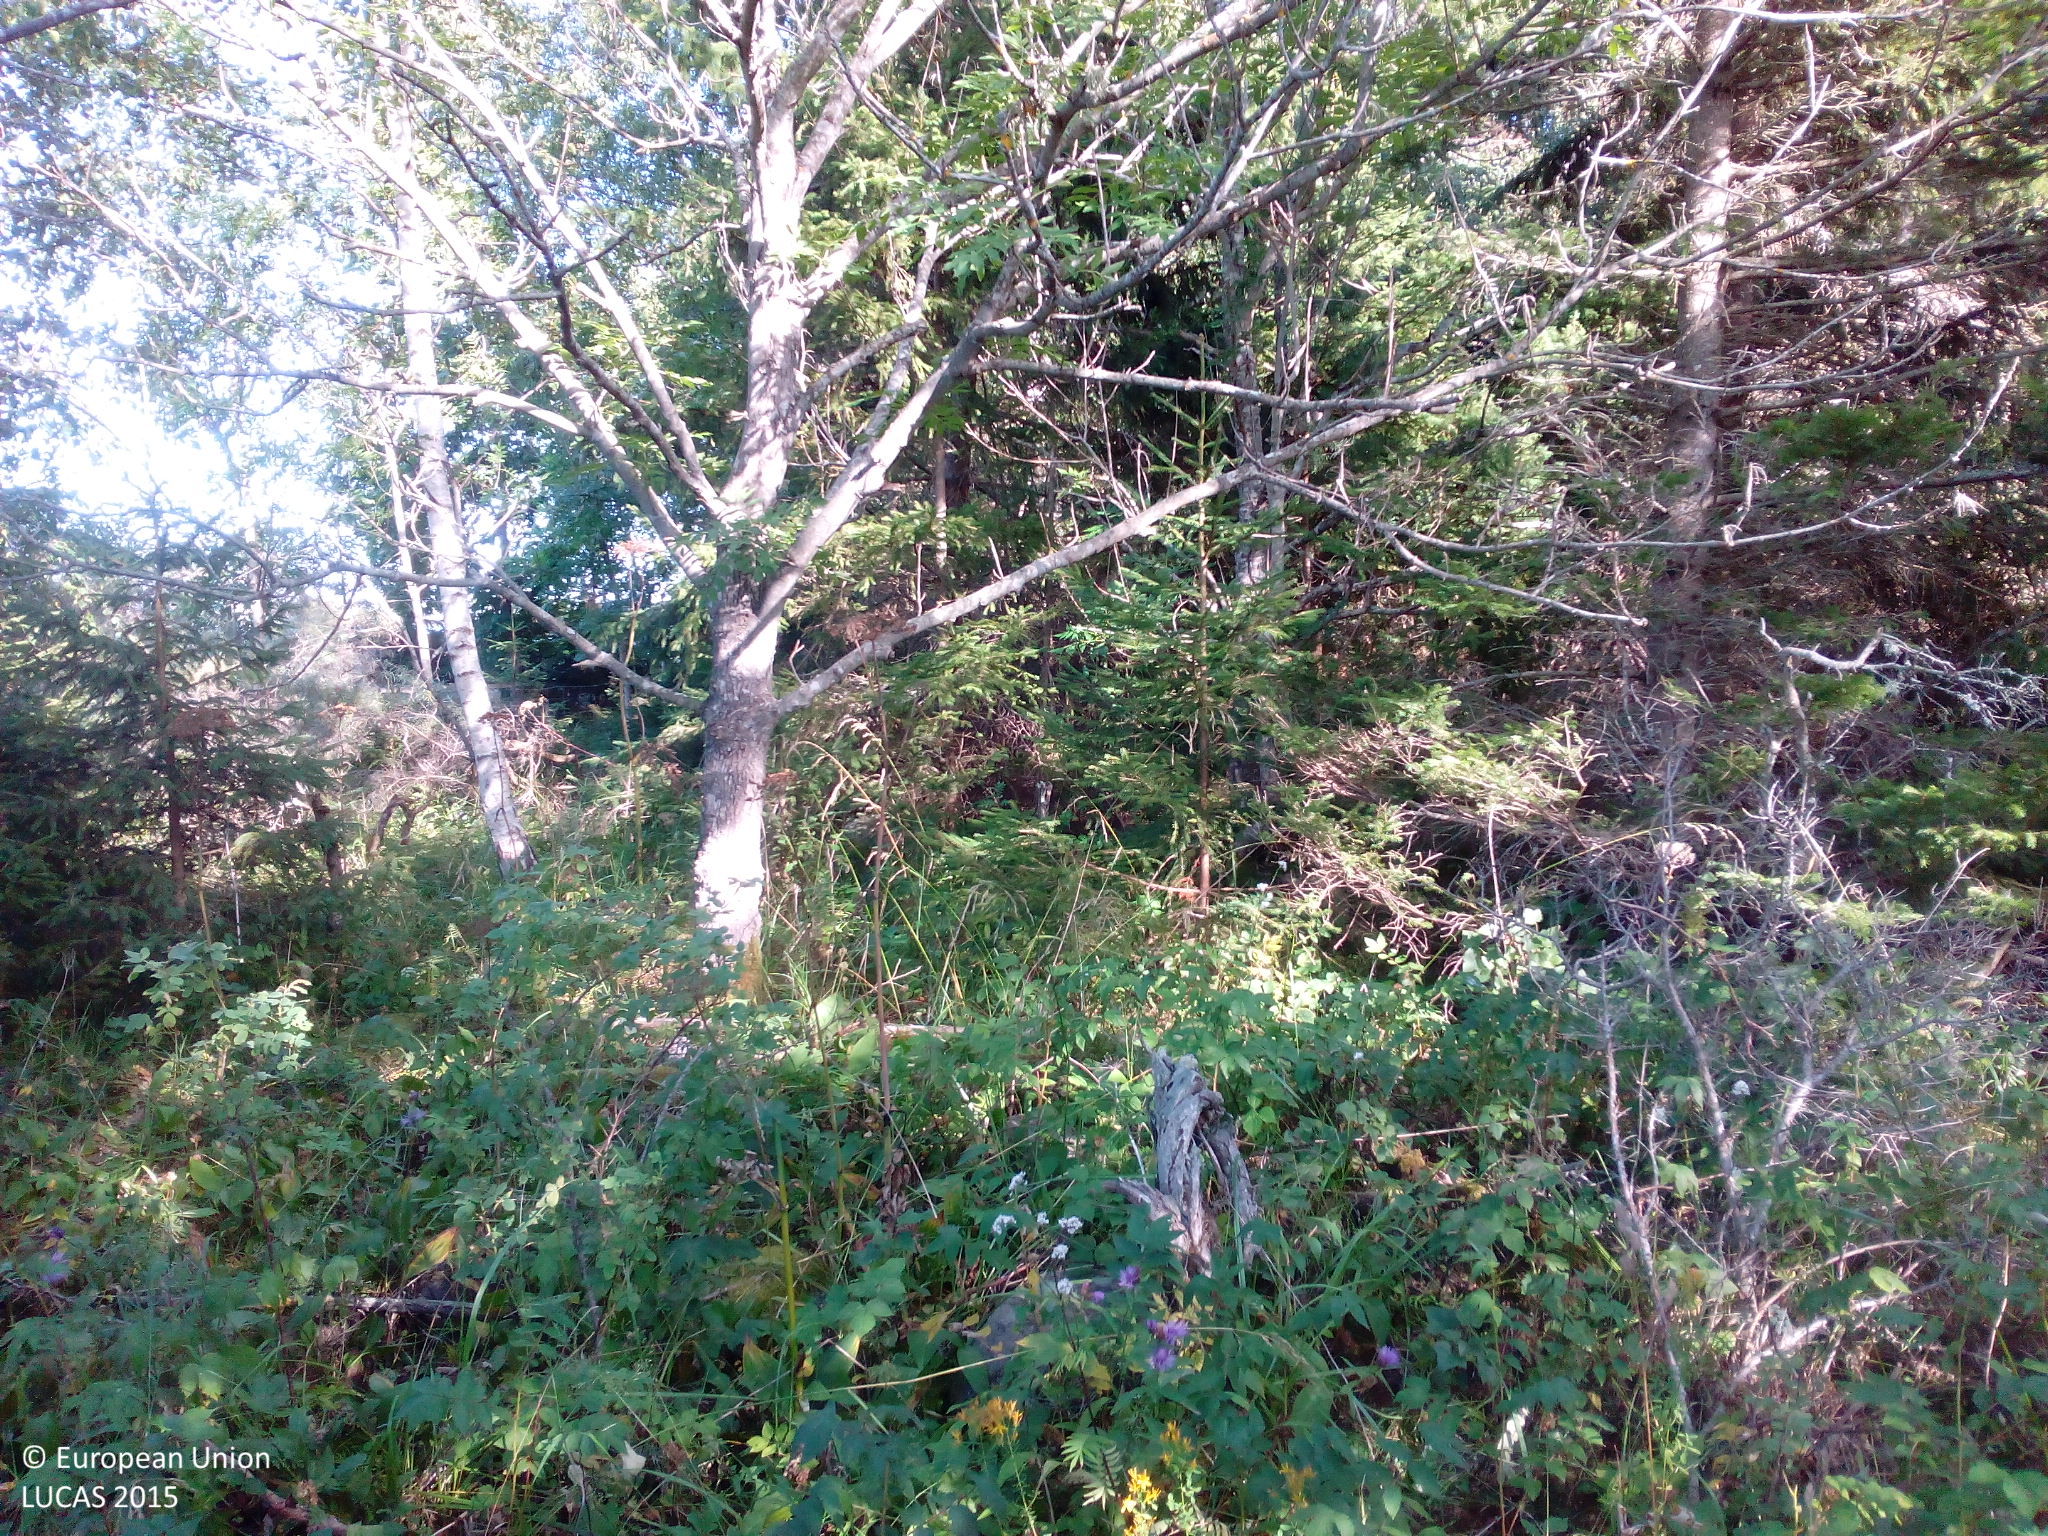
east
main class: Woodland
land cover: Broadleaved woodland
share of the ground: > 75 %
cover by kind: broadleaved forest trees 70 %, herbaceous plants 20 %, coniferous forest trees 10 %
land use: Semi-natural and natural areas not in use
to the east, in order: Broadleaved woodland; Spruce dominated coniferous woodland; Fences; Spruce dominated coniferous woodland; Spruce dominated mixed woodland; Grassland with sparse tree/shrub cover; Rocks and stones
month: August
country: FI
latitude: 60.2983
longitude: 19.7201
